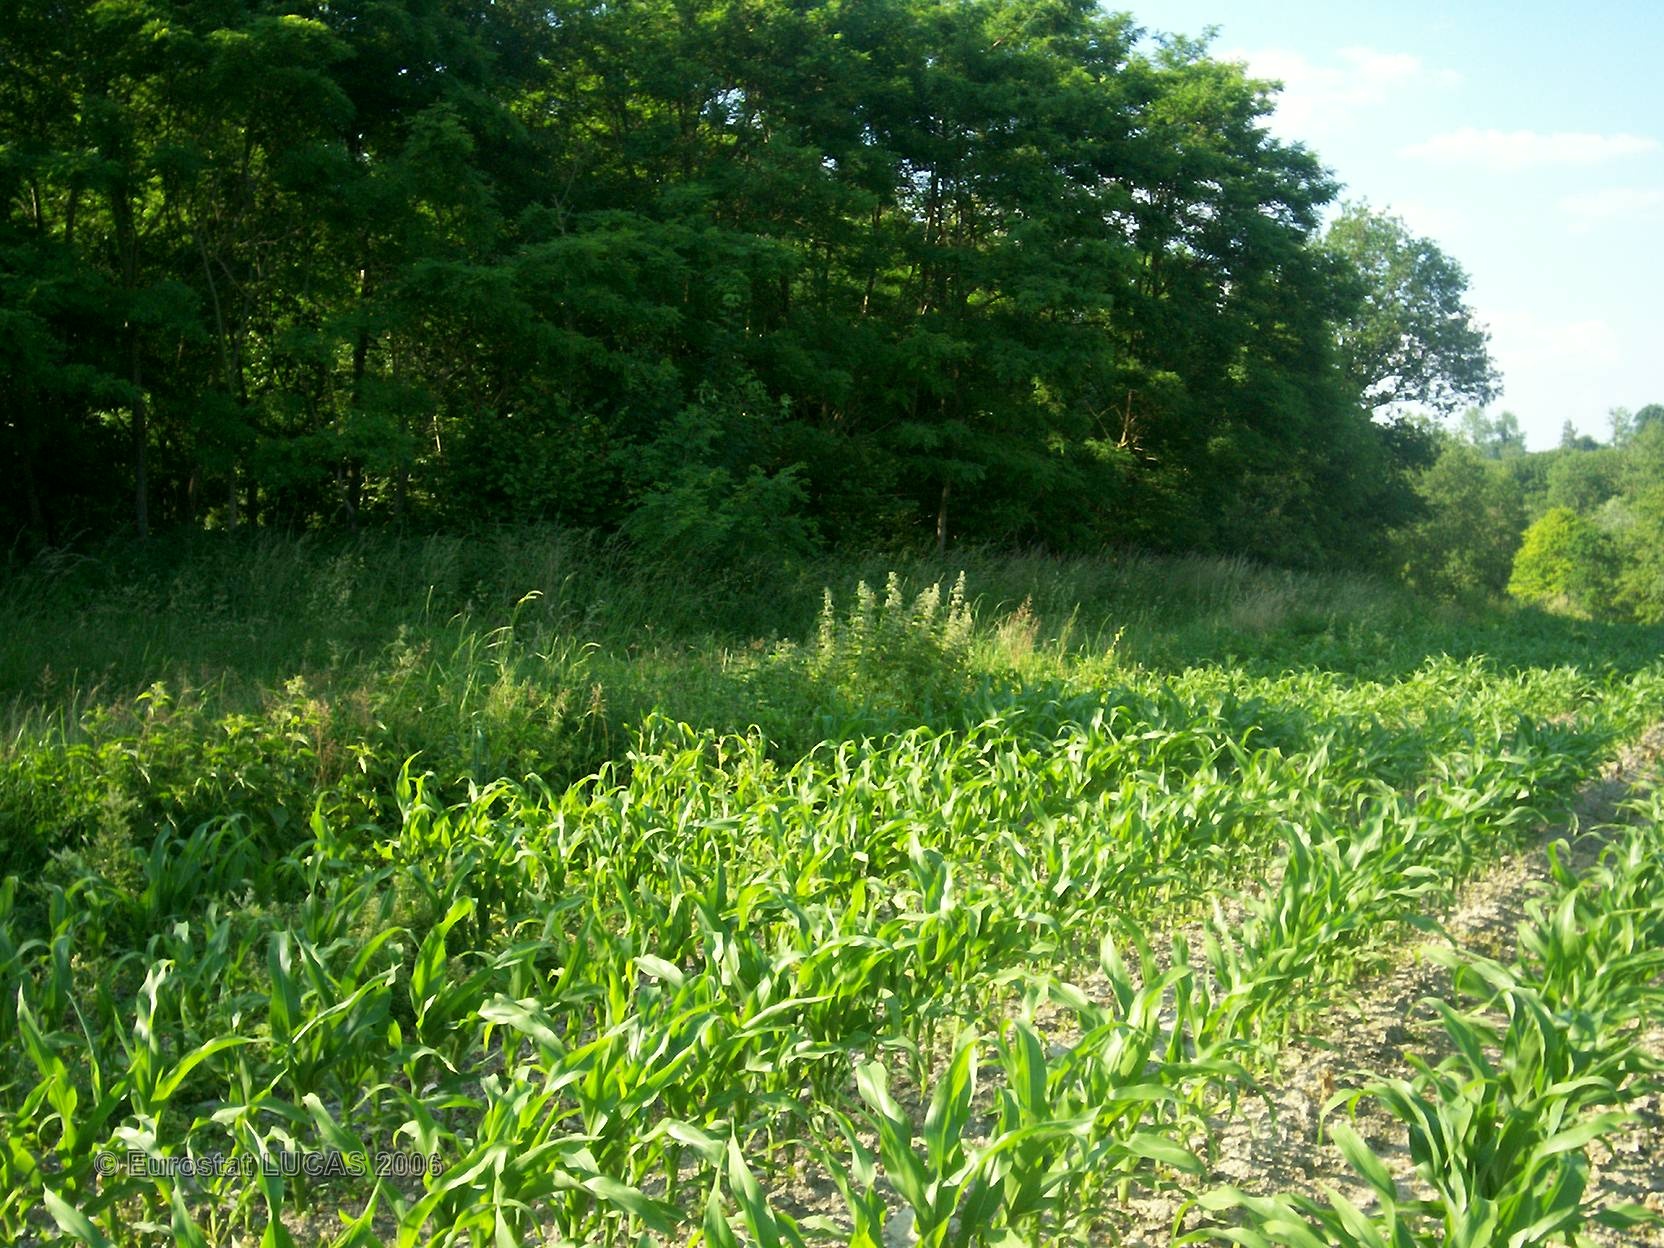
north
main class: Cropland
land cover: Maize
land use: Agriculture (excluding fallow land and kitchen gardens)
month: June
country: FR
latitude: 49.1132
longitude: 4.8600
